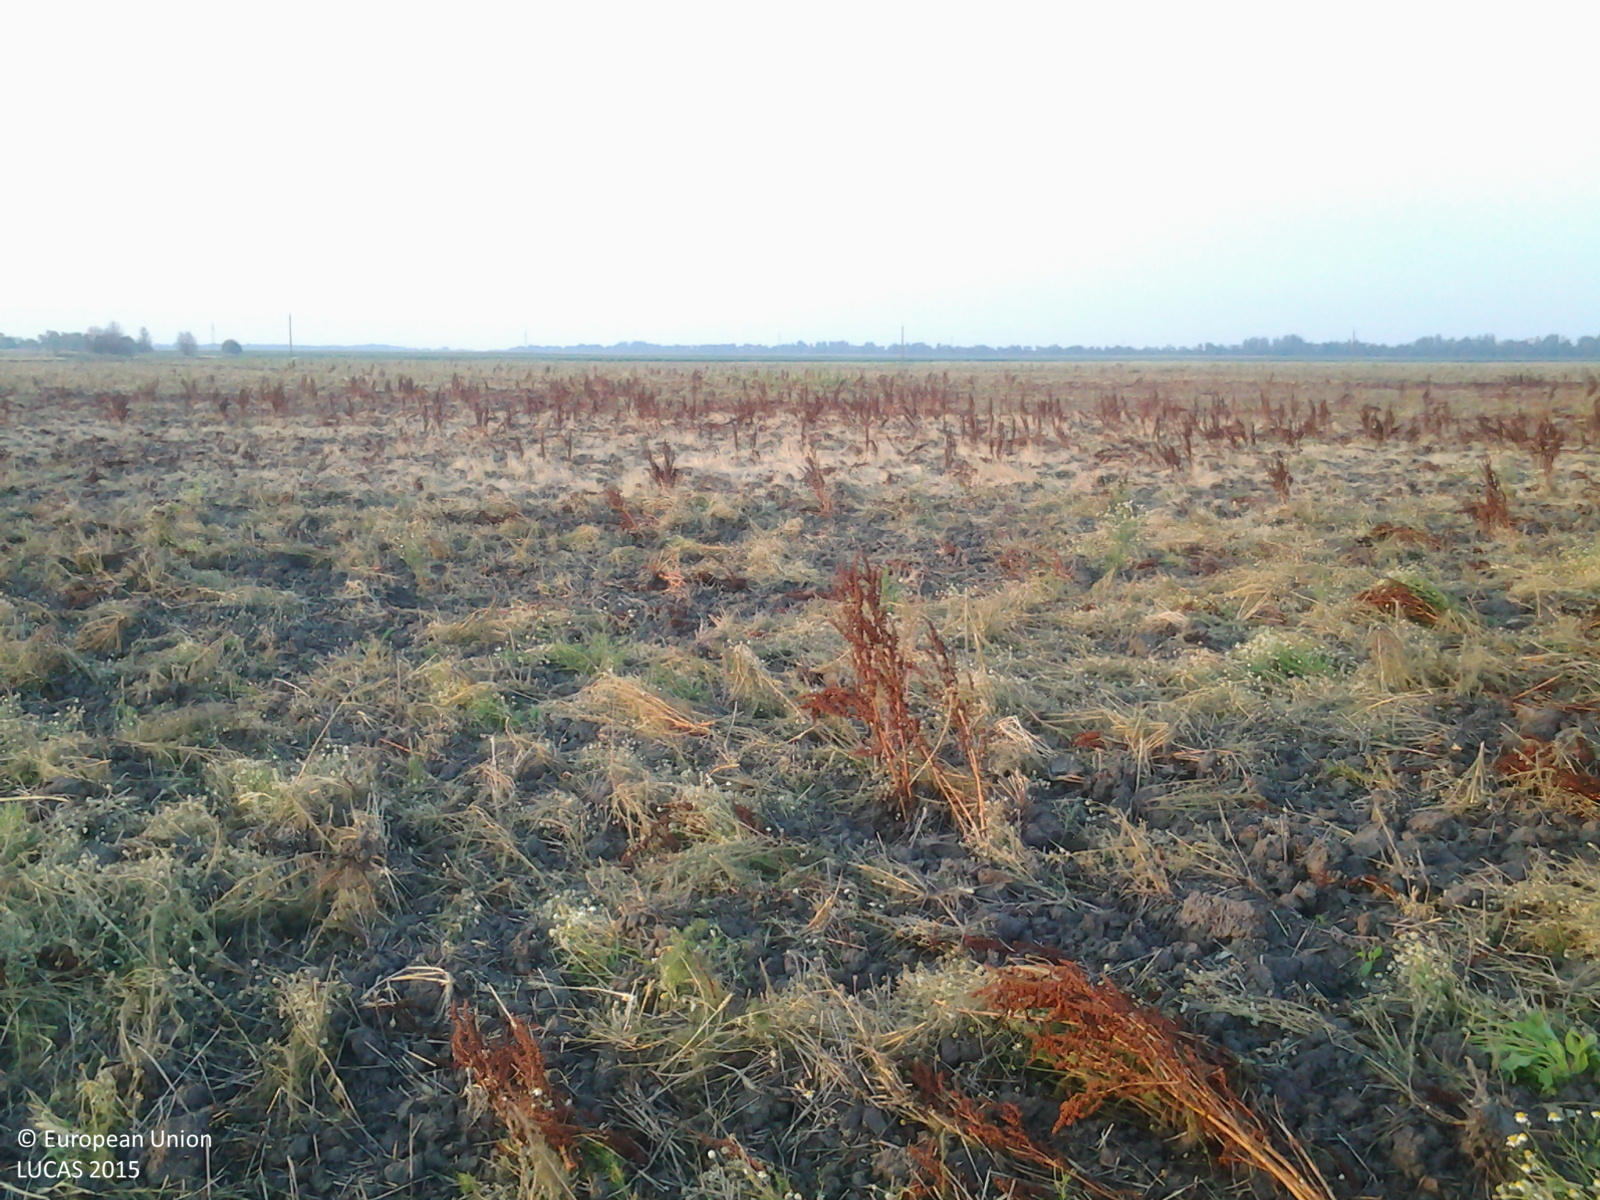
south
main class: Cropland
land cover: Common wheat
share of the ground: < 10 %
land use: Agriculture (excluding fallow land and kitchen gardens)
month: July
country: HU
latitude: 47.0853
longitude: 20.6874
